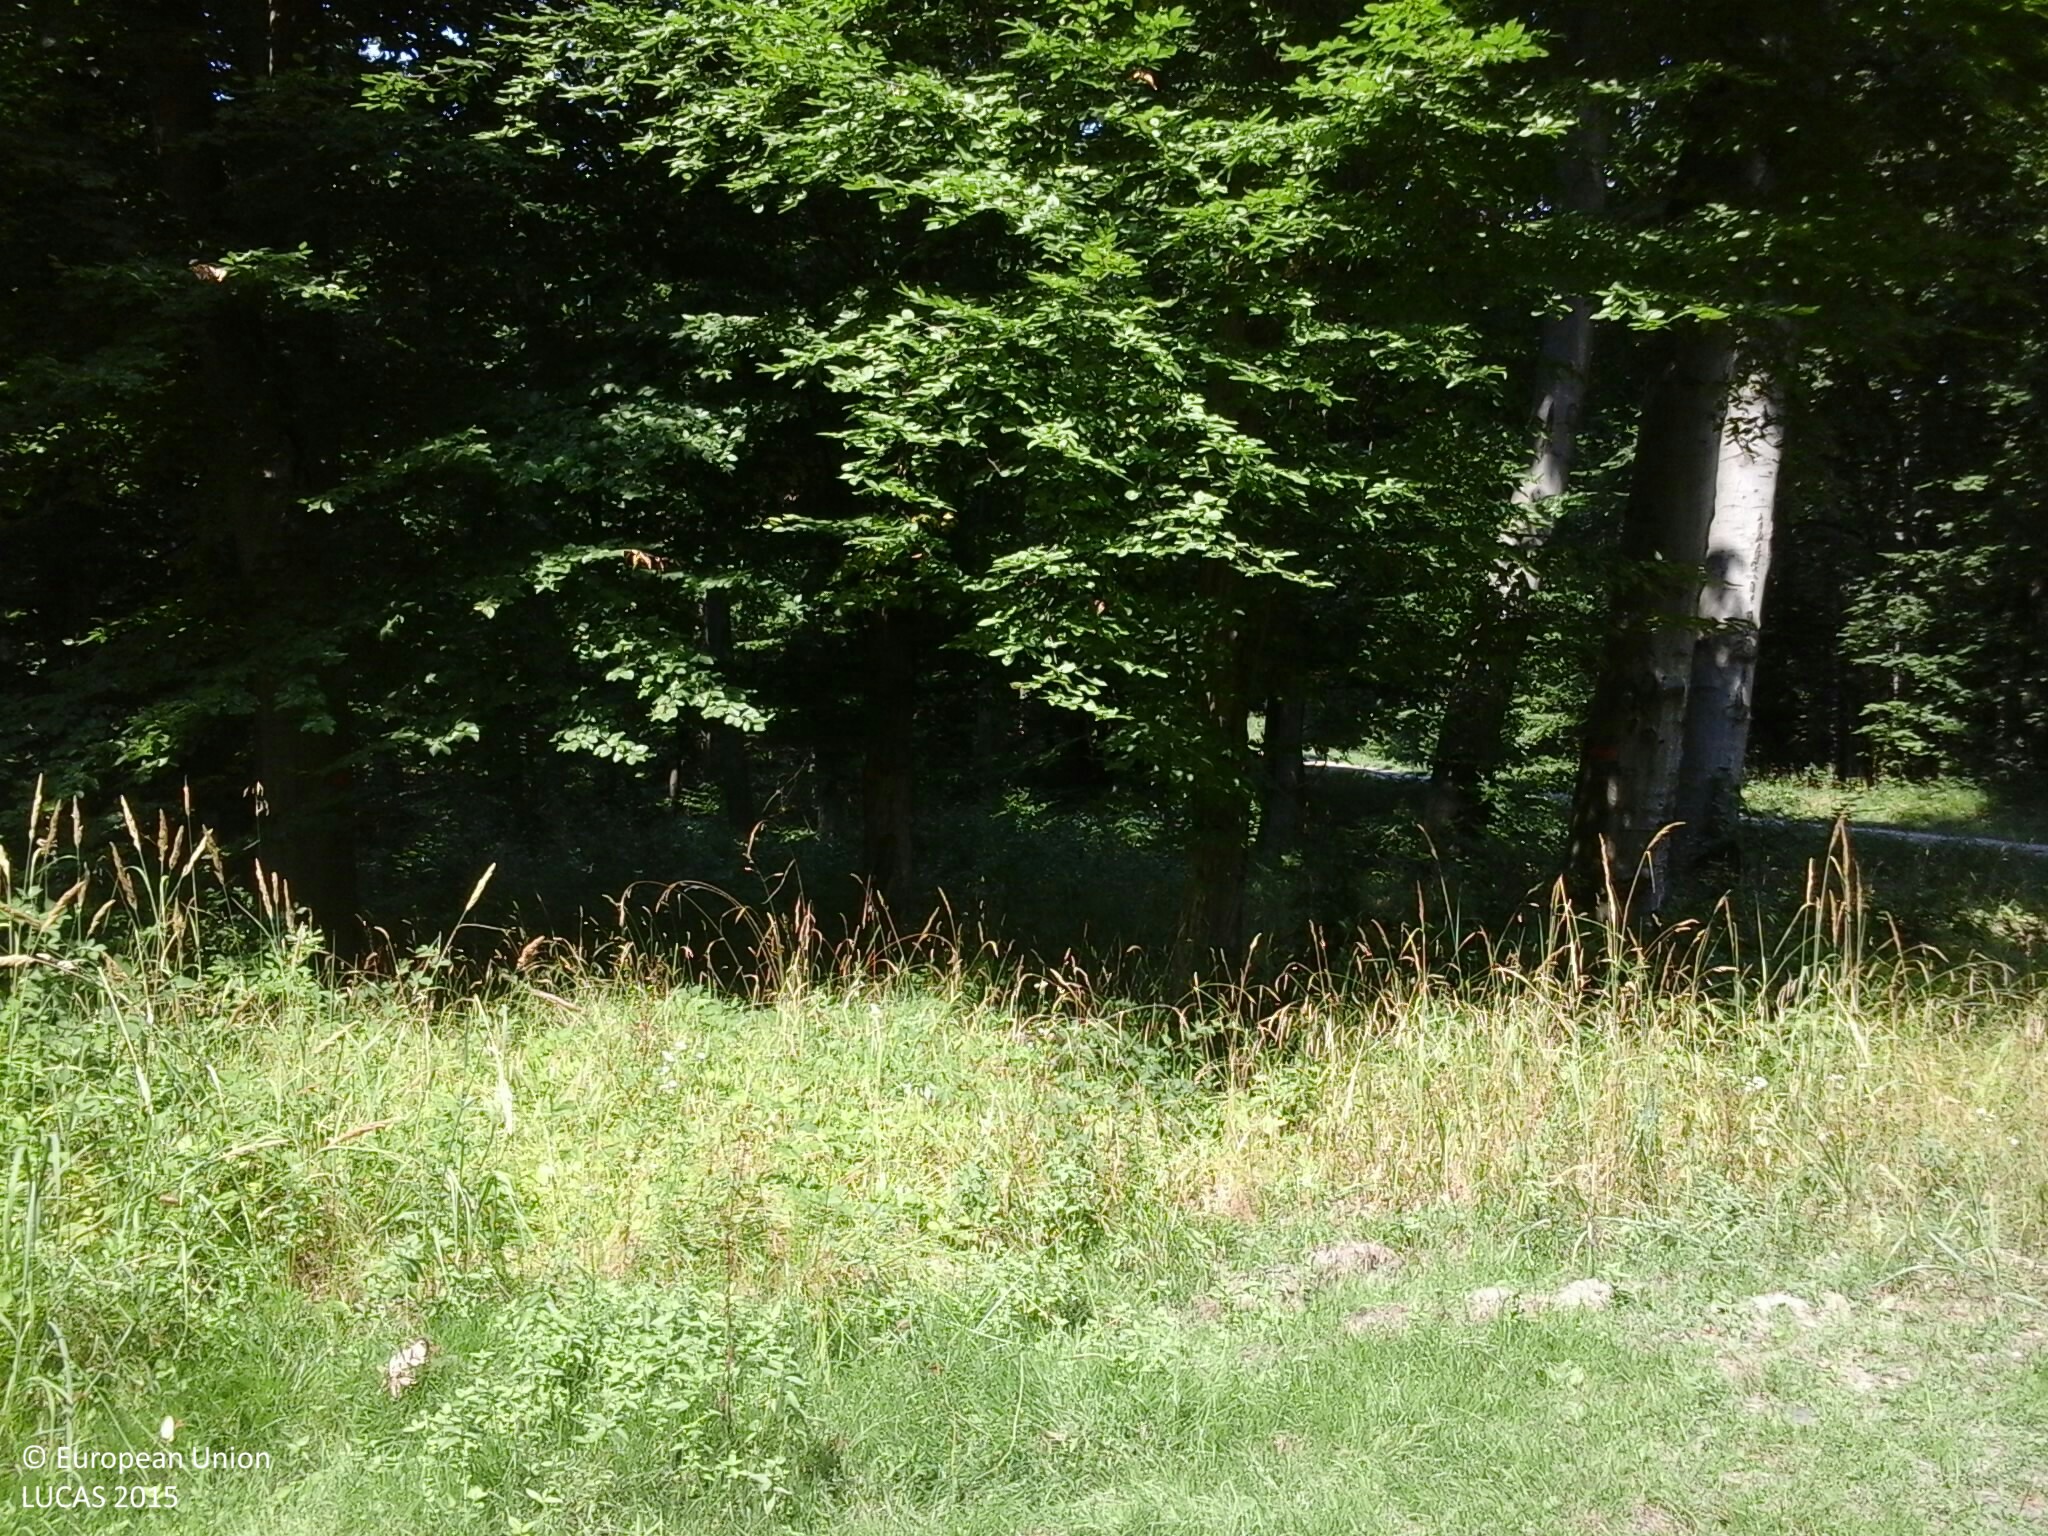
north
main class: Woodland
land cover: Broadleaved woodland
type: beech forest
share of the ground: > 75 %
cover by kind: broadleaved forest trees 100 %
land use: Forestry
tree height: > 5 m
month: August
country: HU
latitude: 46.1285
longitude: 18.1737
